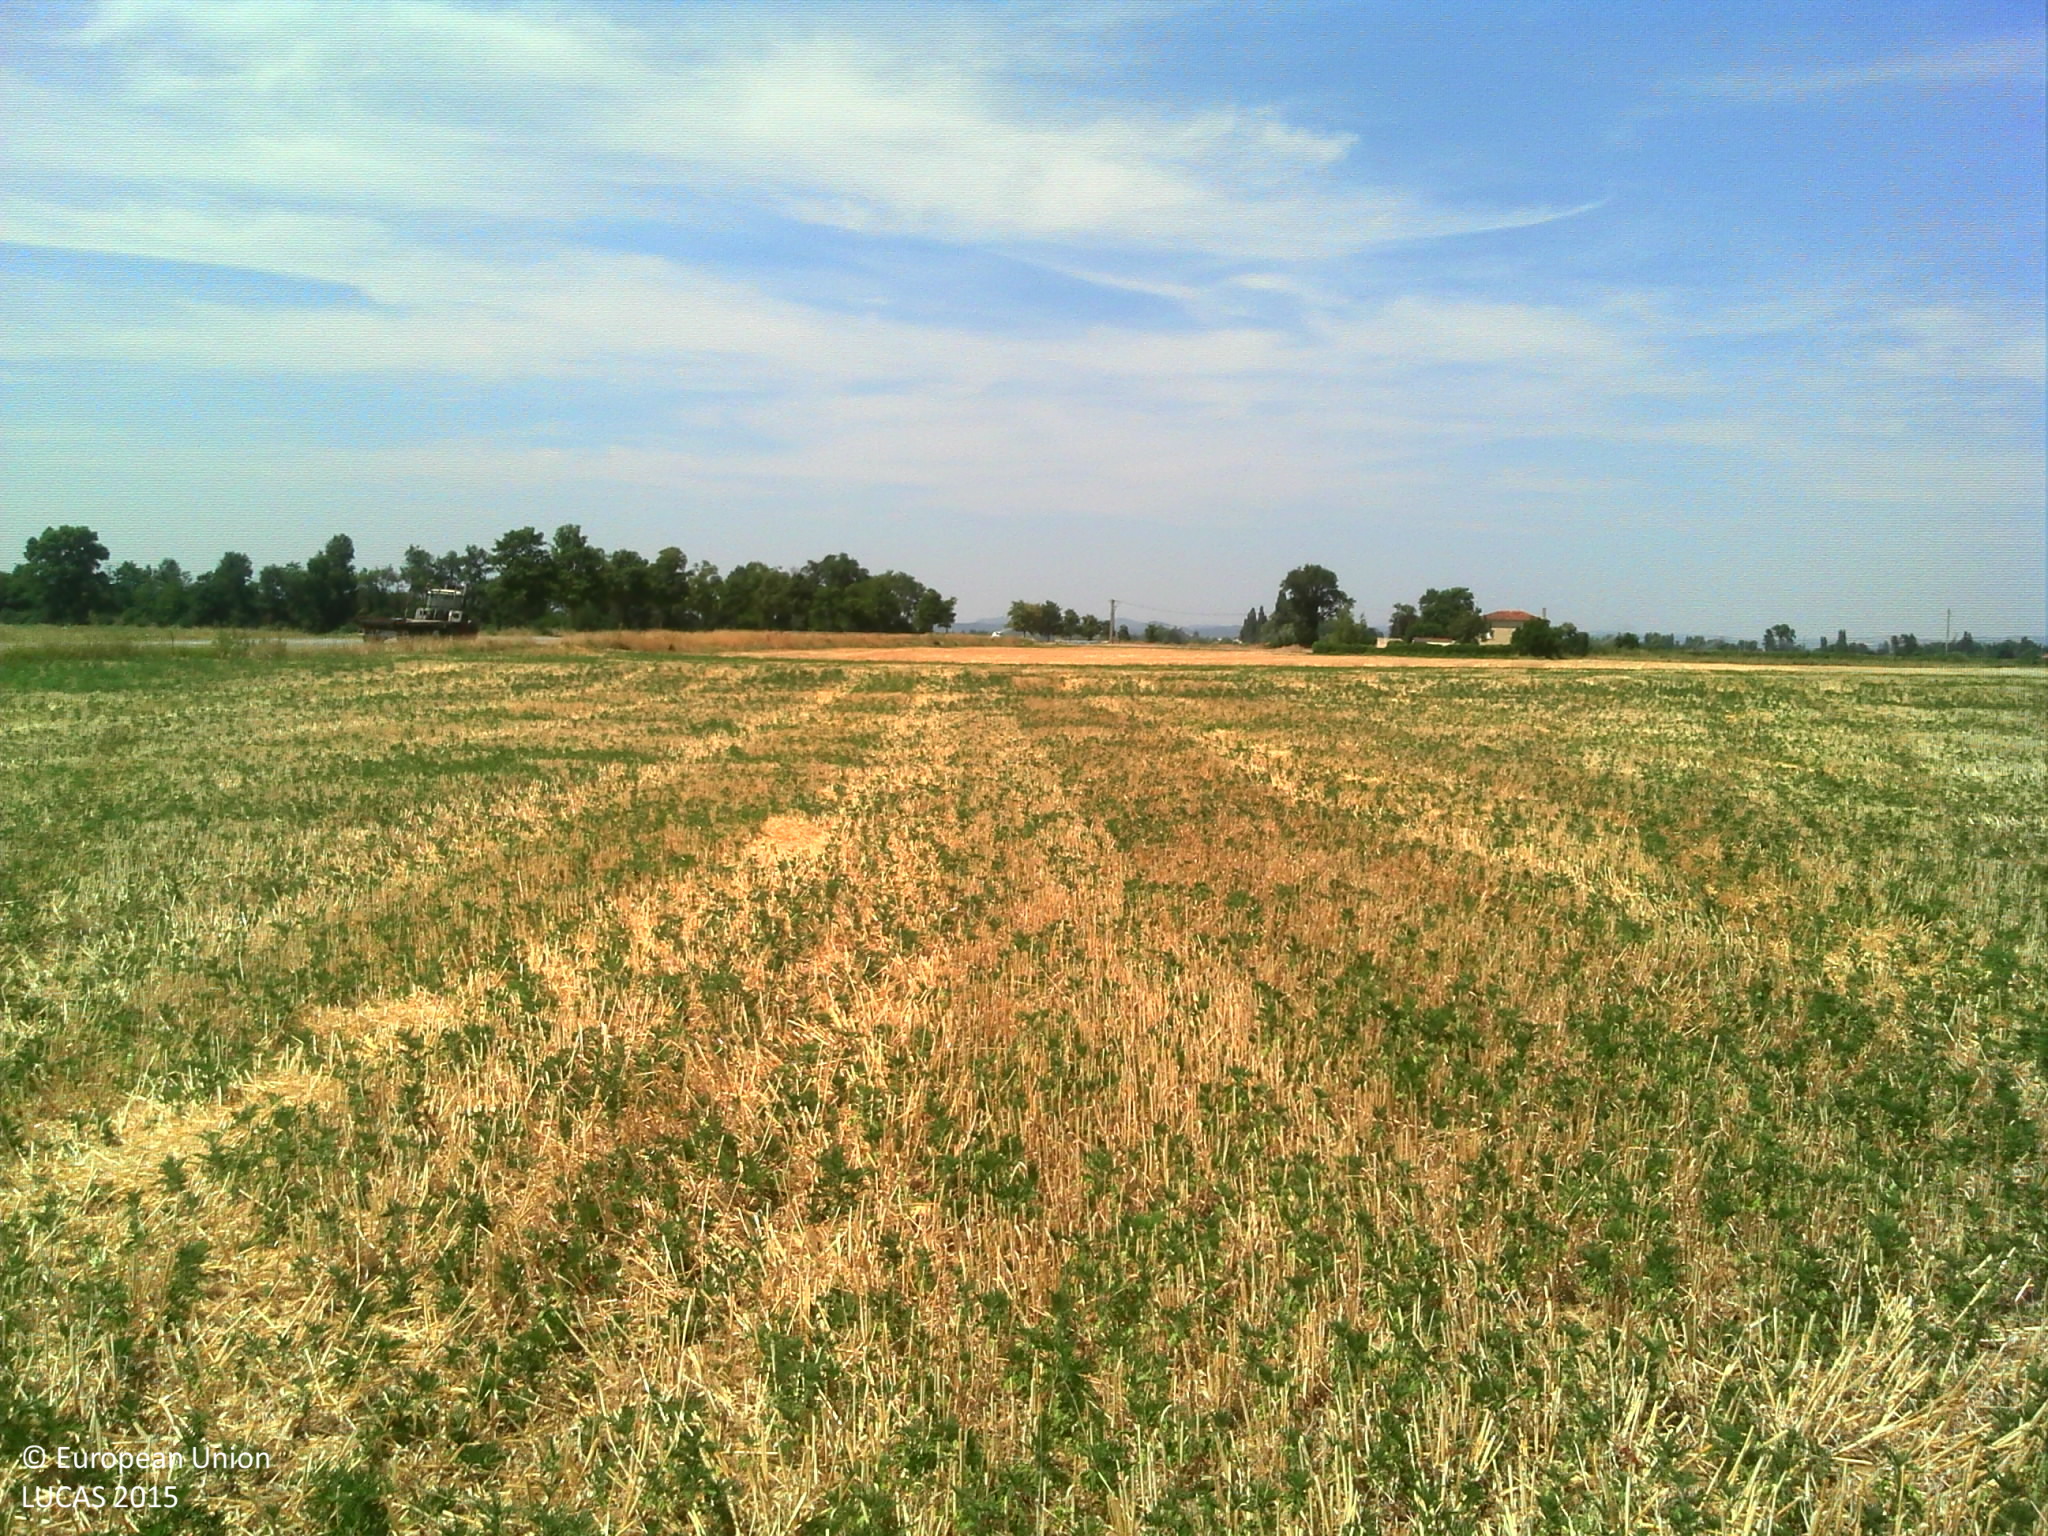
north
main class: Cropland
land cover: Barley
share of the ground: > 75 %
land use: Agriculture (excluding fallow land and kitchen gardens)
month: July
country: FR
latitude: 44.9538
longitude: 5.0242
